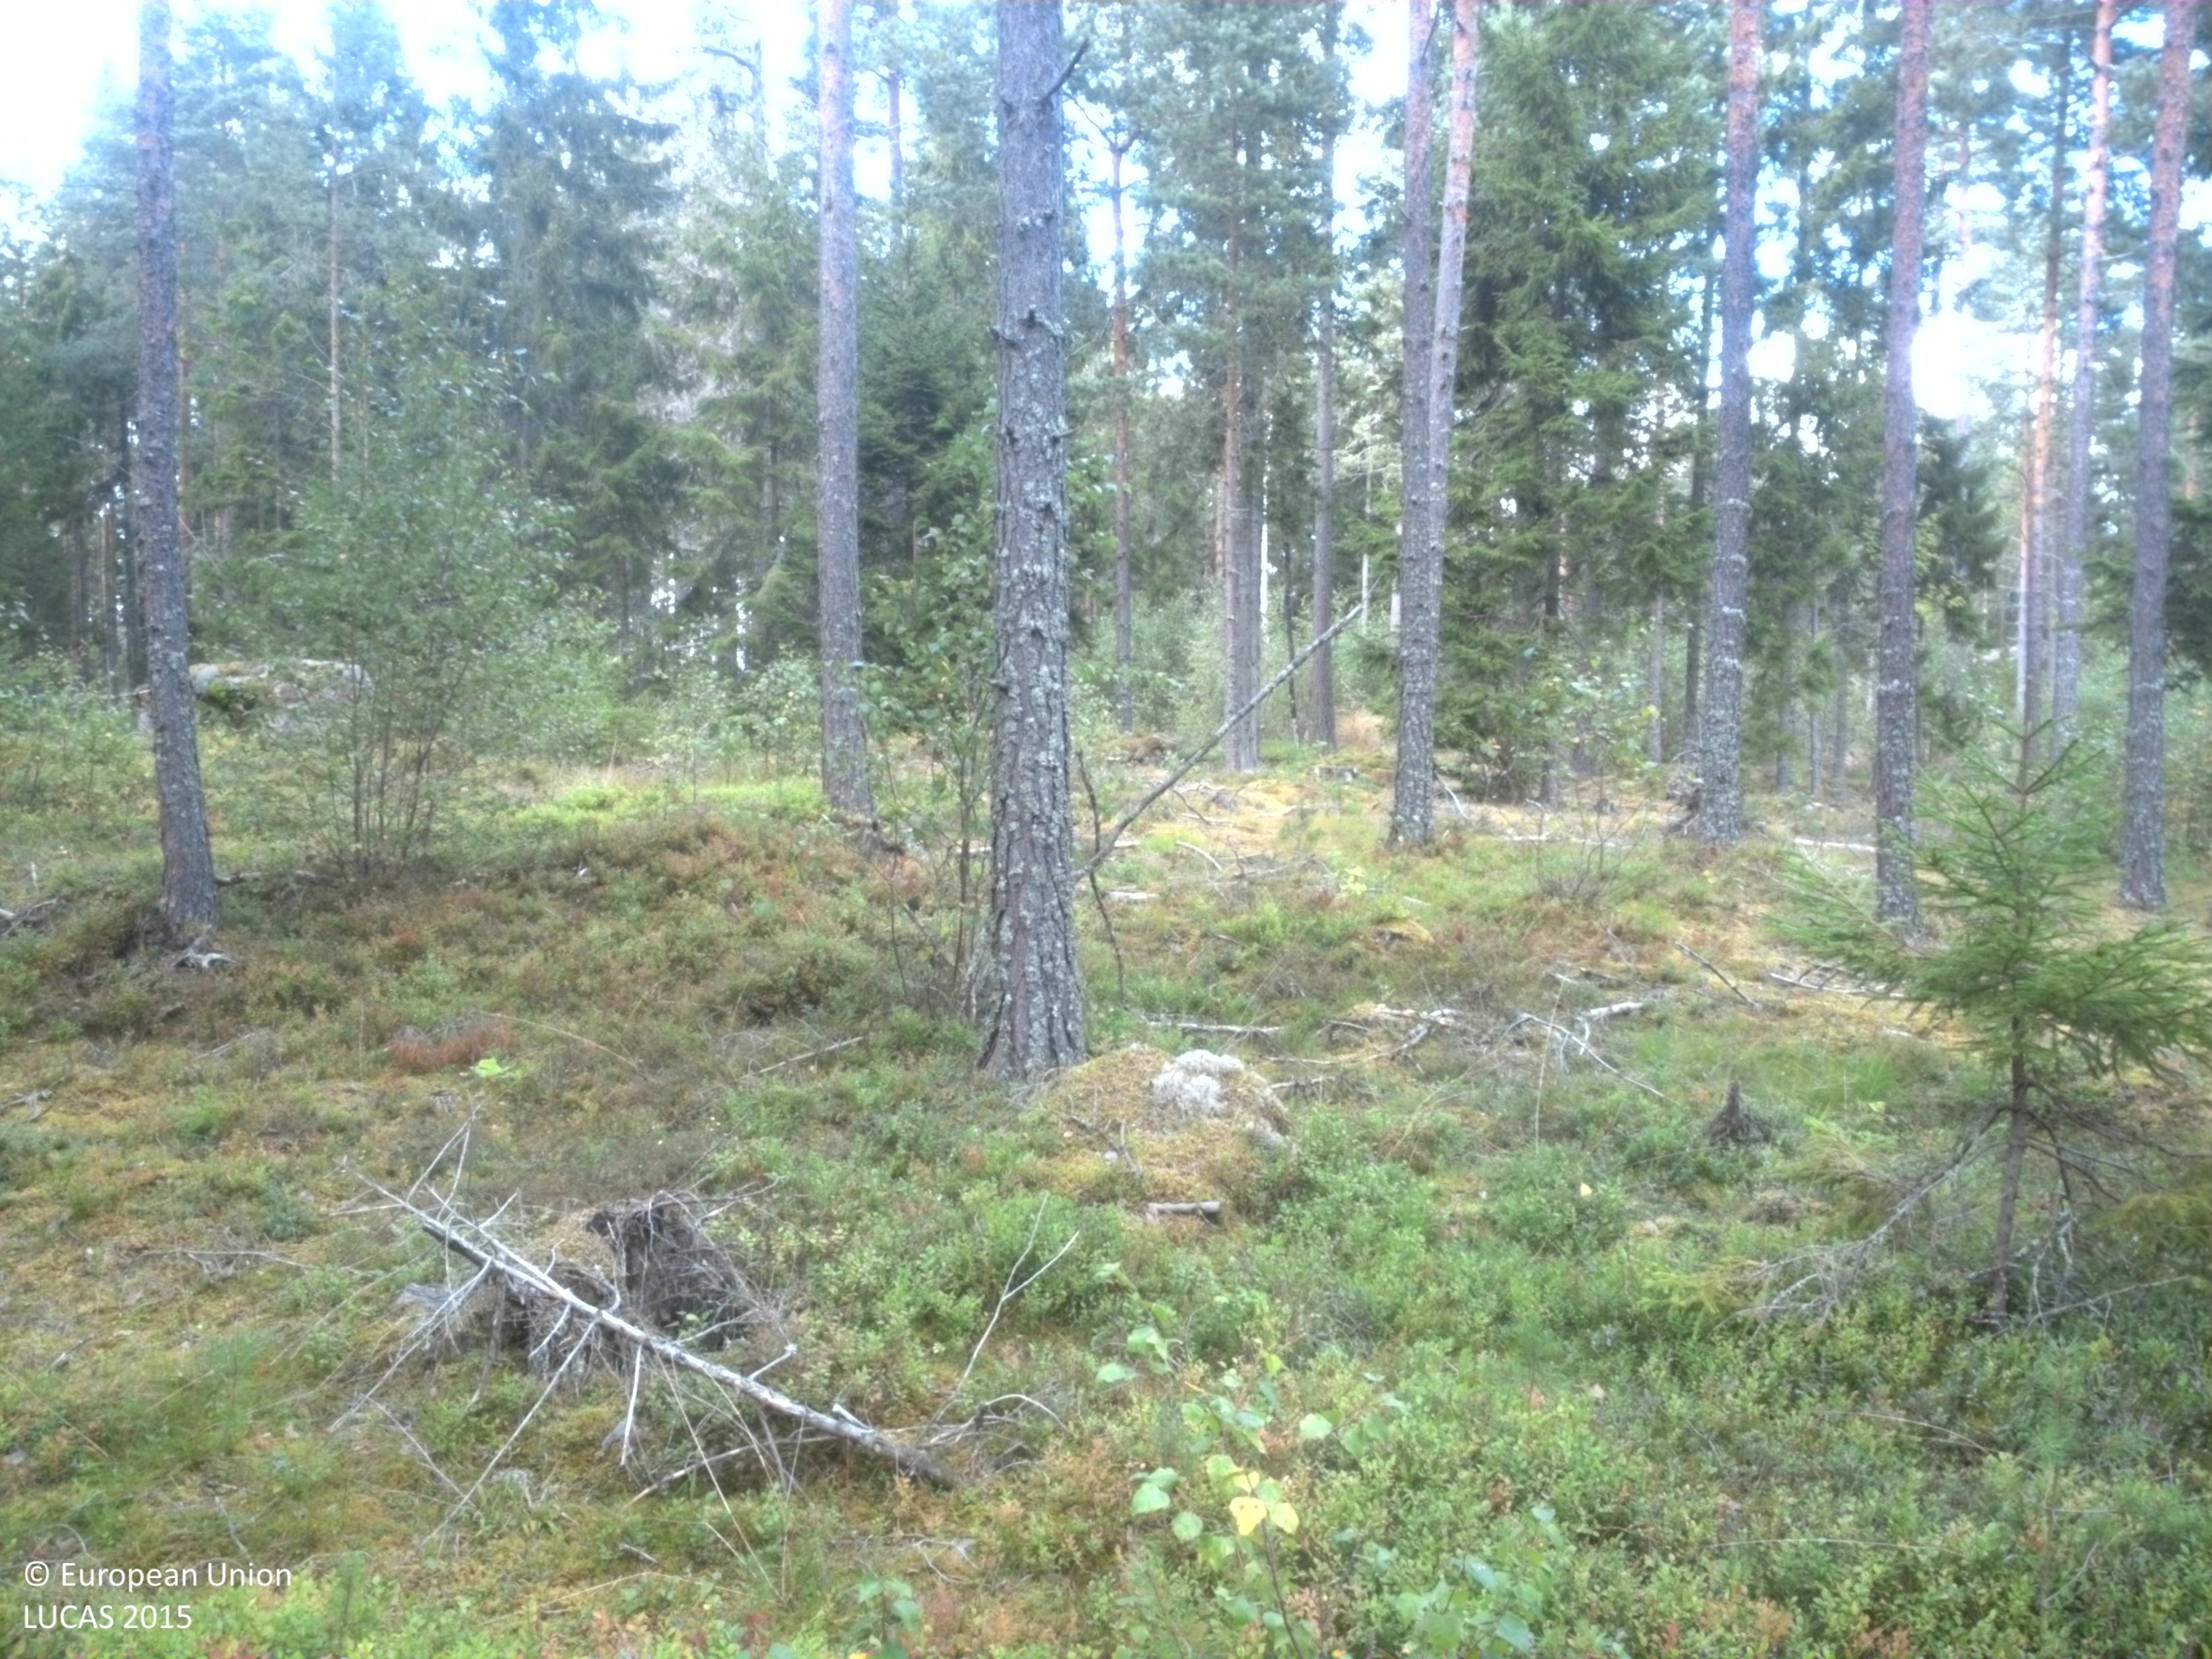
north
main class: Woodland
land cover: Pine dominated coniferous woodland
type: boreal forest
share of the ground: 50 - 75 %
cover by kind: coniferous forest trees 45 %, shrubs 30 %, lichens and mosses 20 %, broadleaved forest trees 5 %
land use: Forestry
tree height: > 5 m
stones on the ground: < 10 %
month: August
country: SE
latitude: 59.4551
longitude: 15.6188
